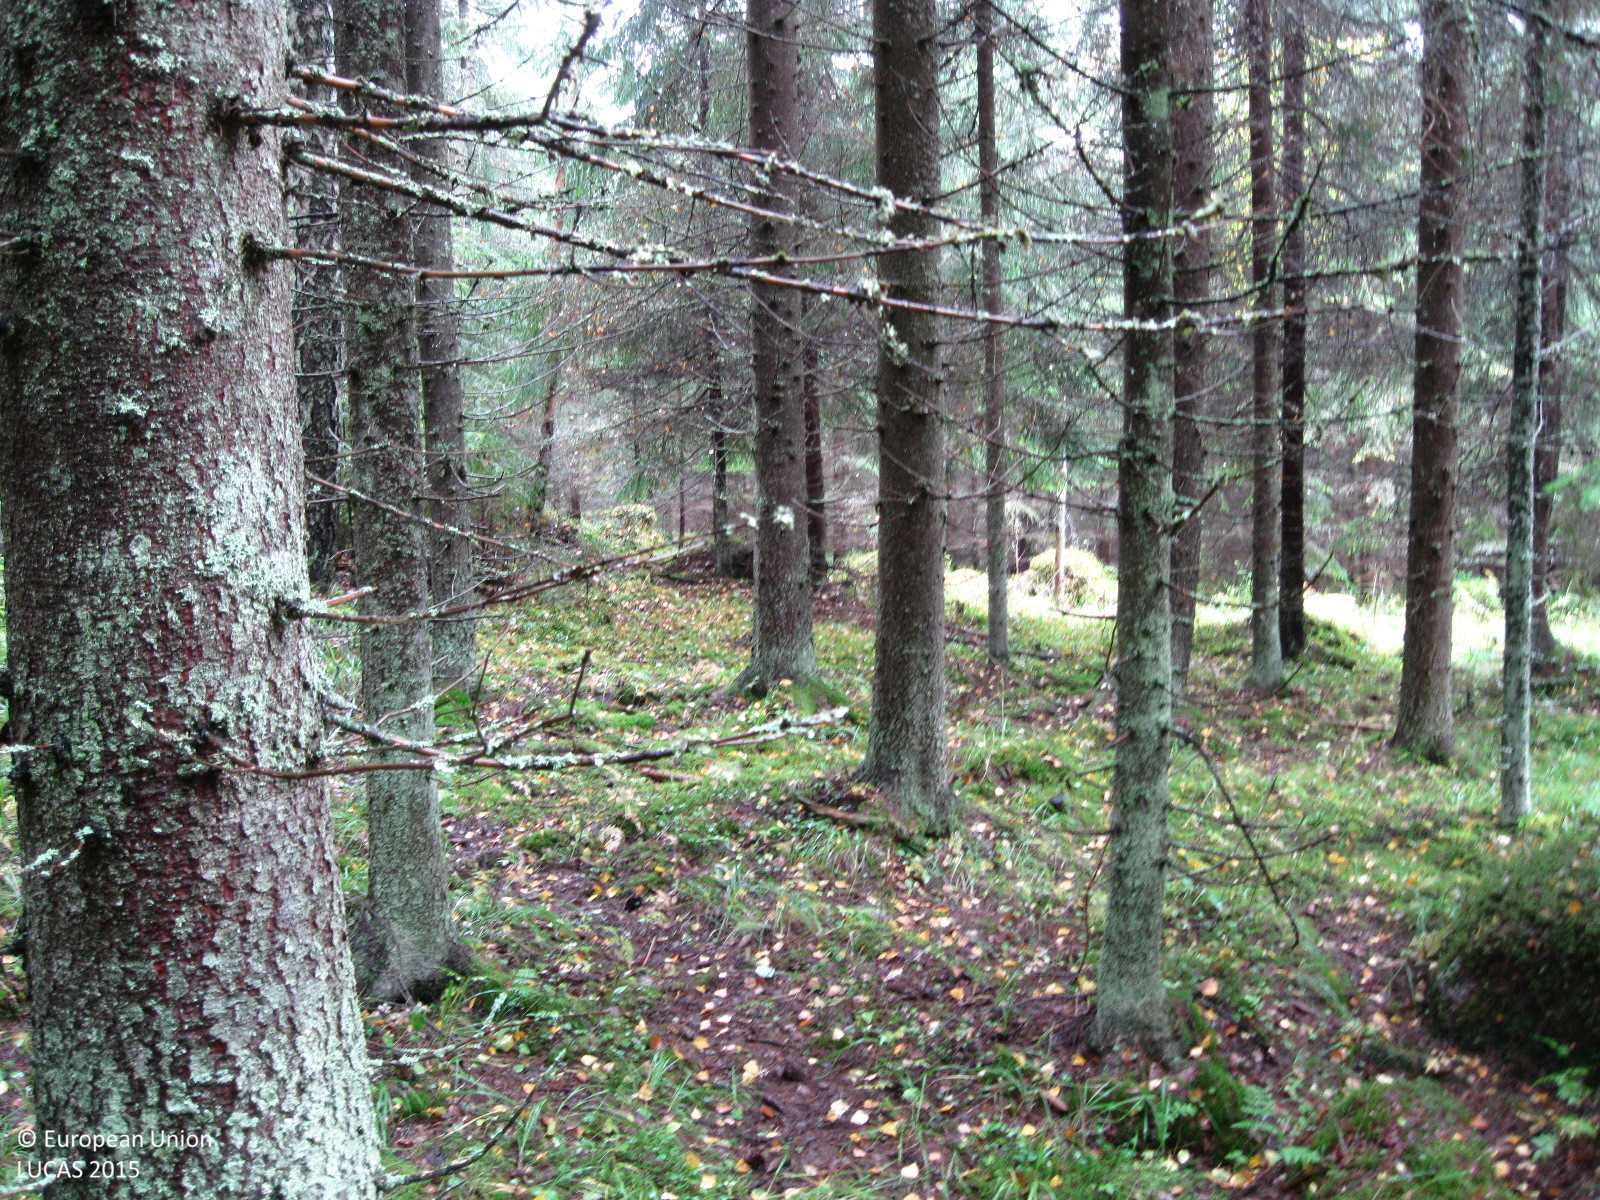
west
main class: Woodland
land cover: Spruce dominated coniferous woodland
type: boreal forest
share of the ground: > 75 %
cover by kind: coniferous forest trees 60 %, broadleaved forest trees 15 %, herbaceous plants 15 %, lichens and mosses 10 %
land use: Forestry
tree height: > 5 m
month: September
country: FI
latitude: 60.8309
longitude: 24.5810
